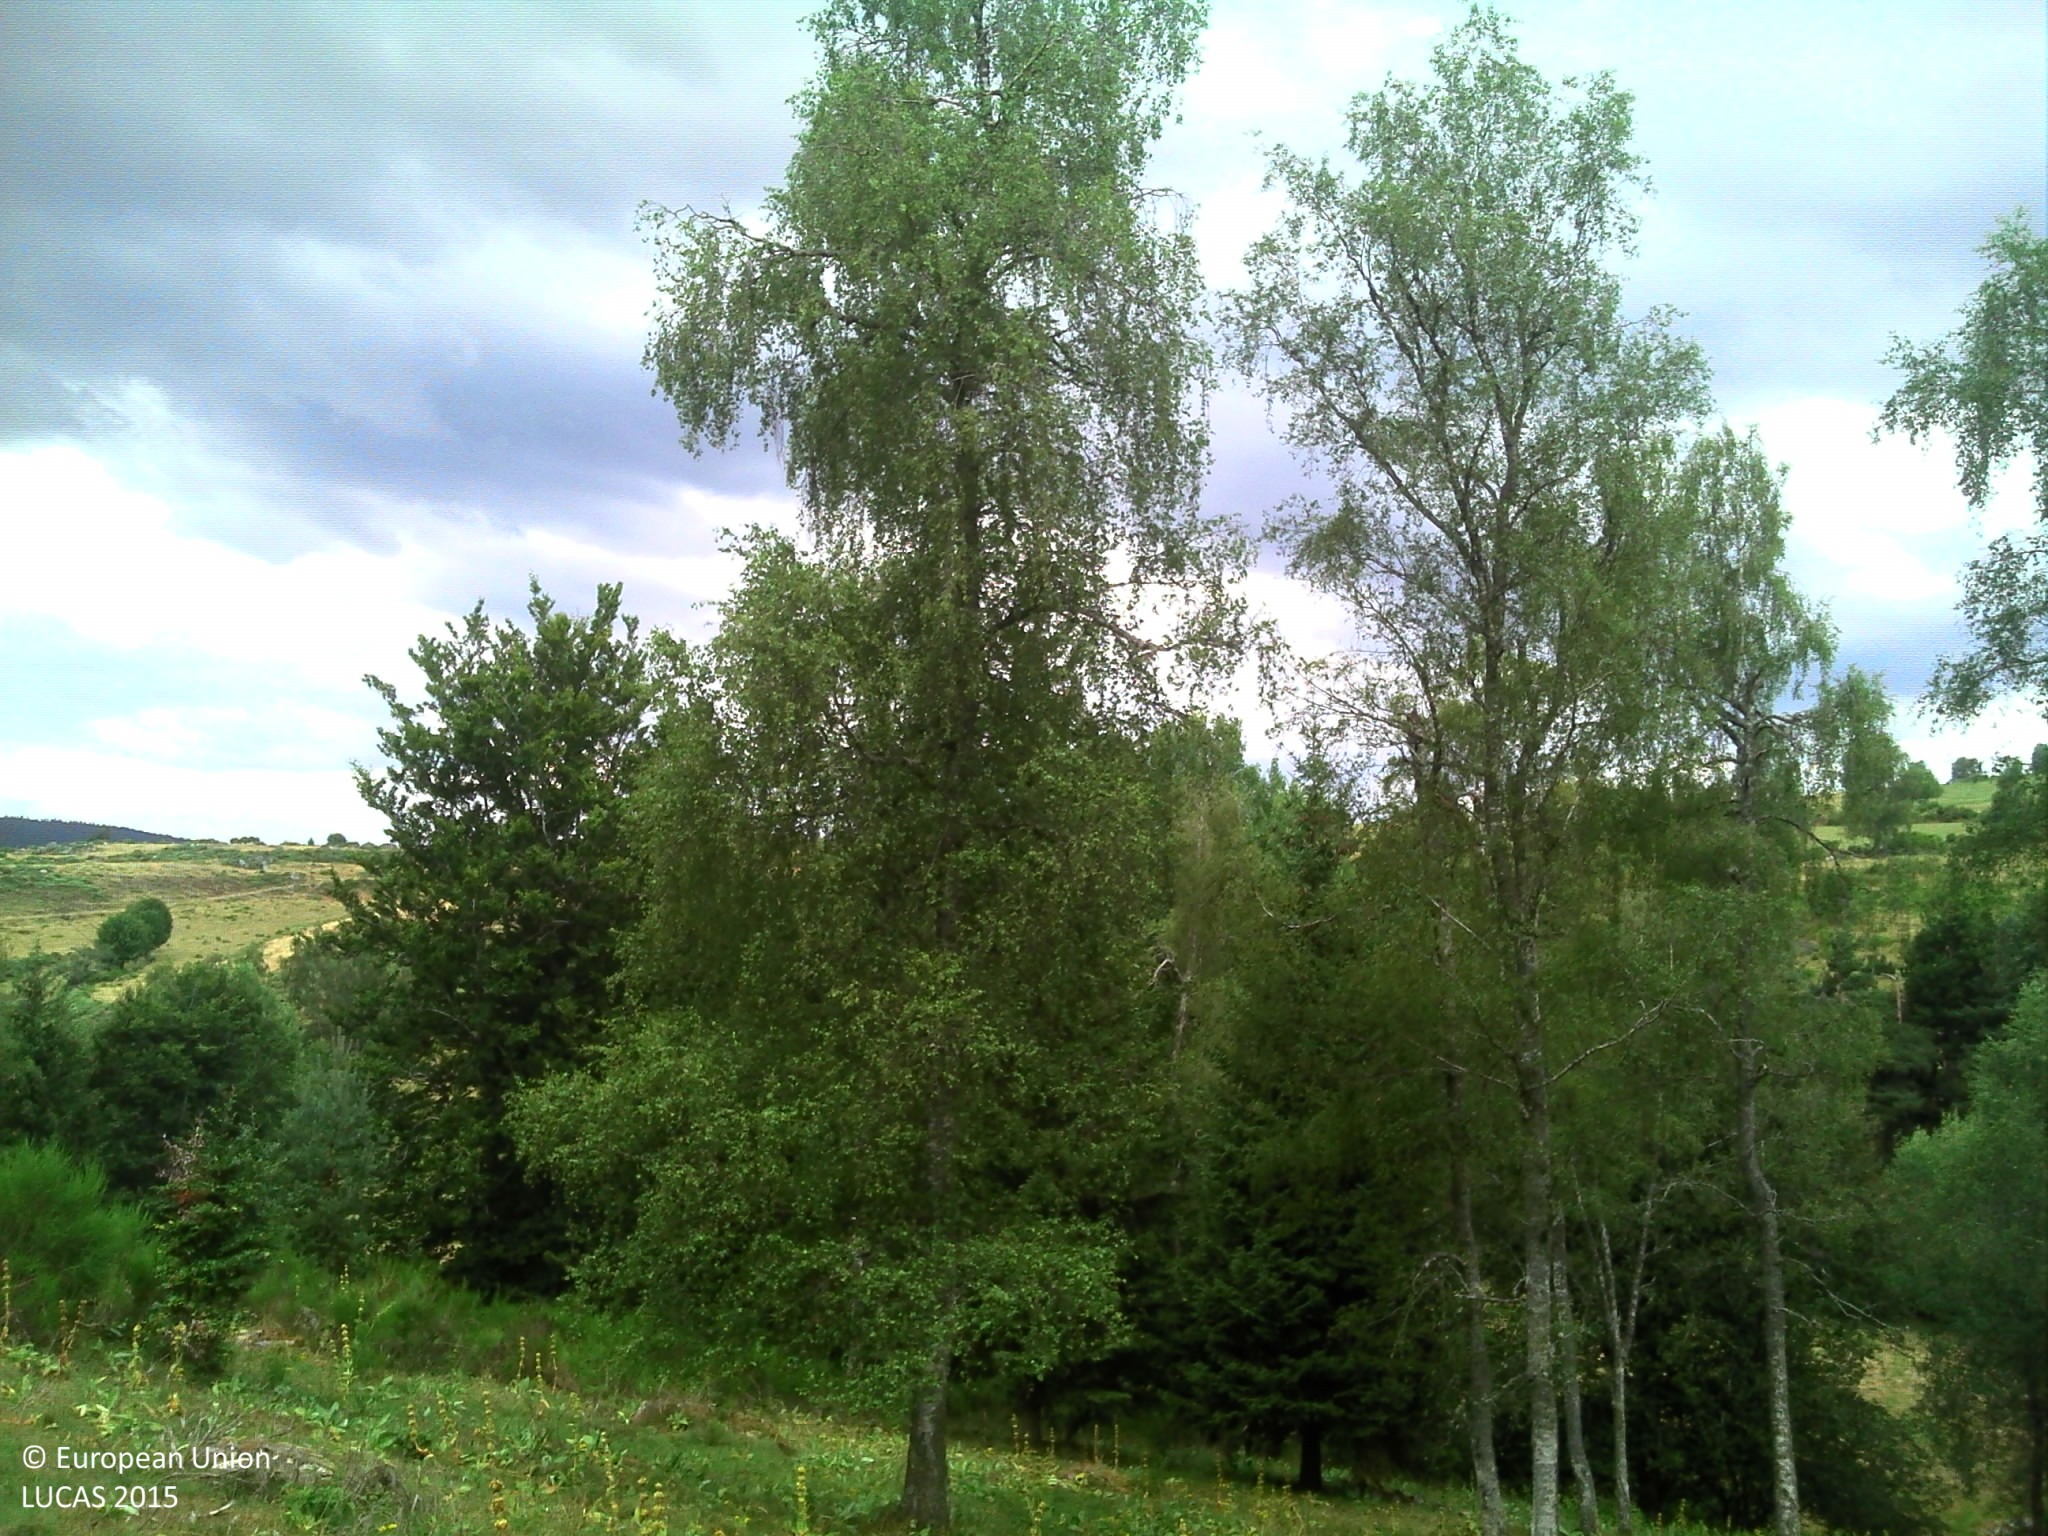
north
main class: Grassland
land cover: Grassland with sparse tree/shrub cover
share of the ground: > 75 %
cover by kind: herbaceous plants 85 %, shrubs 10 %, broadleaved forest trees 5 %
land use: Agriculture (excluding fallow land and kitchen gardens)
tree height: > 5 m
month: July
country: FR
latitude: 44.7699
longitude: 3.0664
